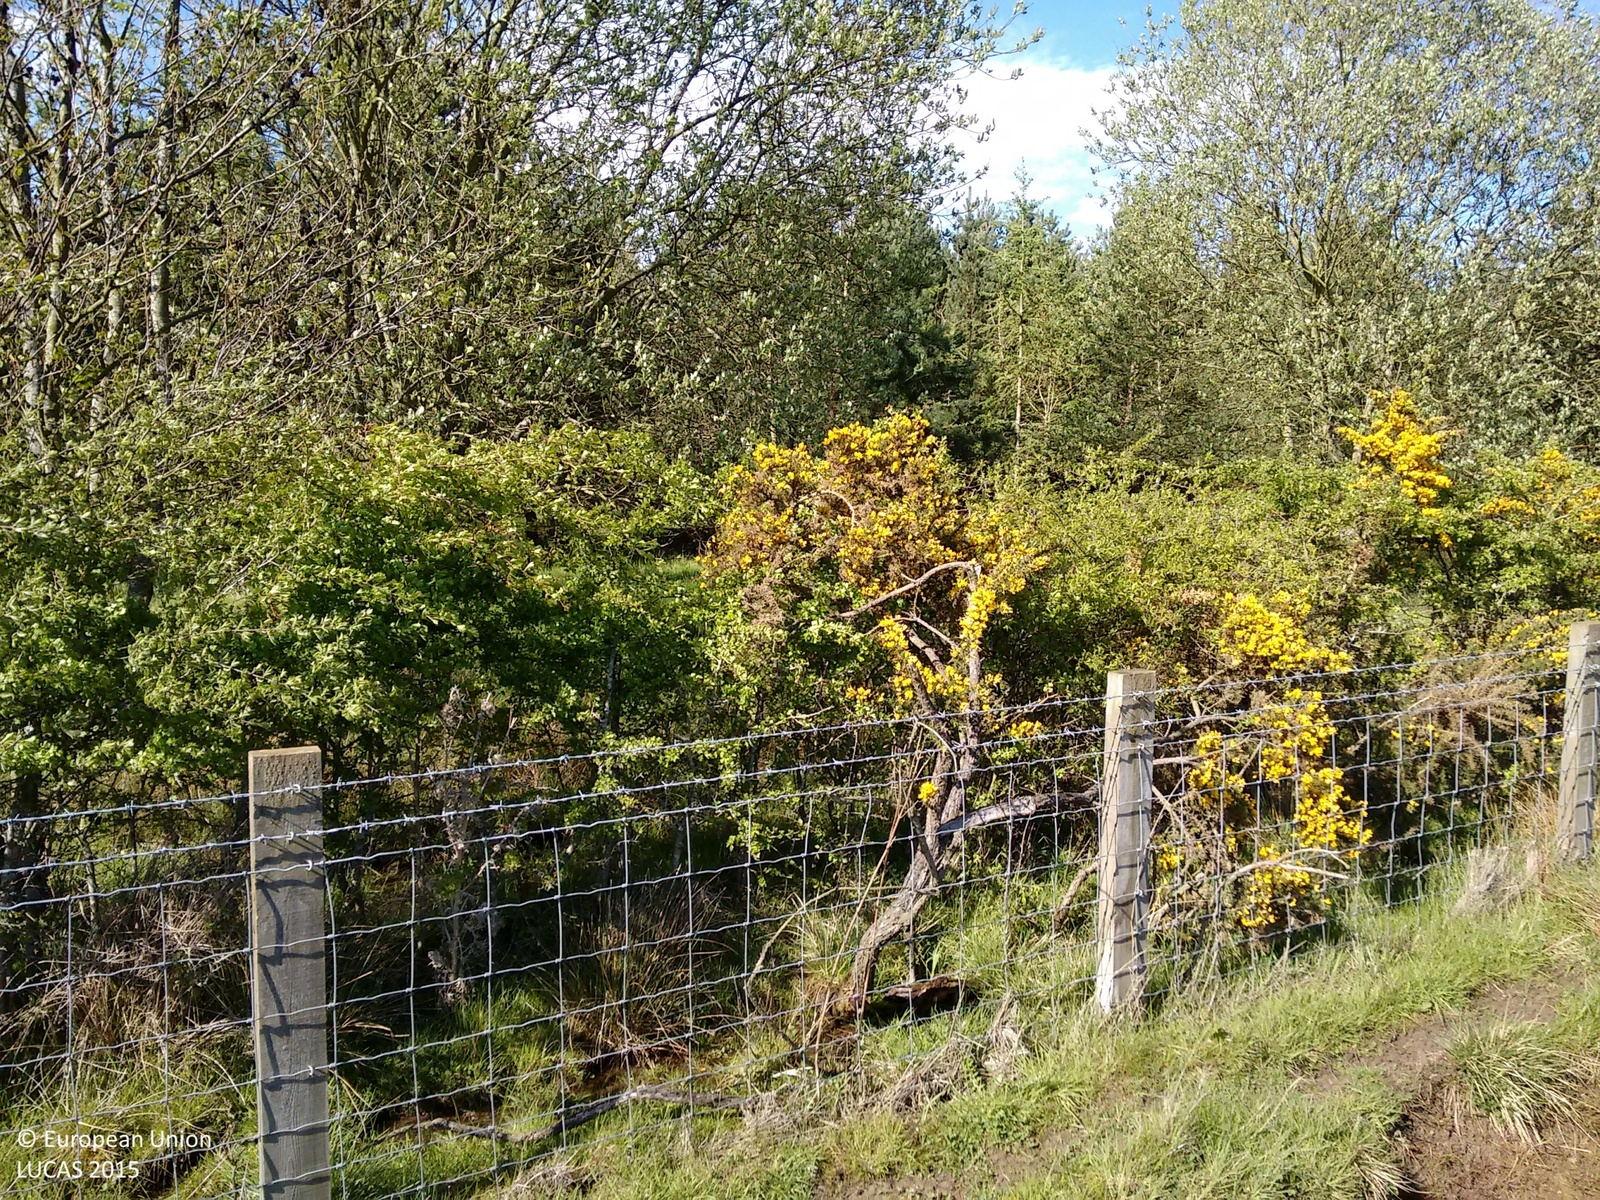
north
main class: Woodland
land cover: Pine dominated coniferous woodland
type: exotic forest
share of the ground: > 75 %
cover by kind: coniferous forest trees 100 %
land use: Forestry
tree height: > 5 m
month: May
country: GB
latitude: 55.1966
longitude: -1.6905
